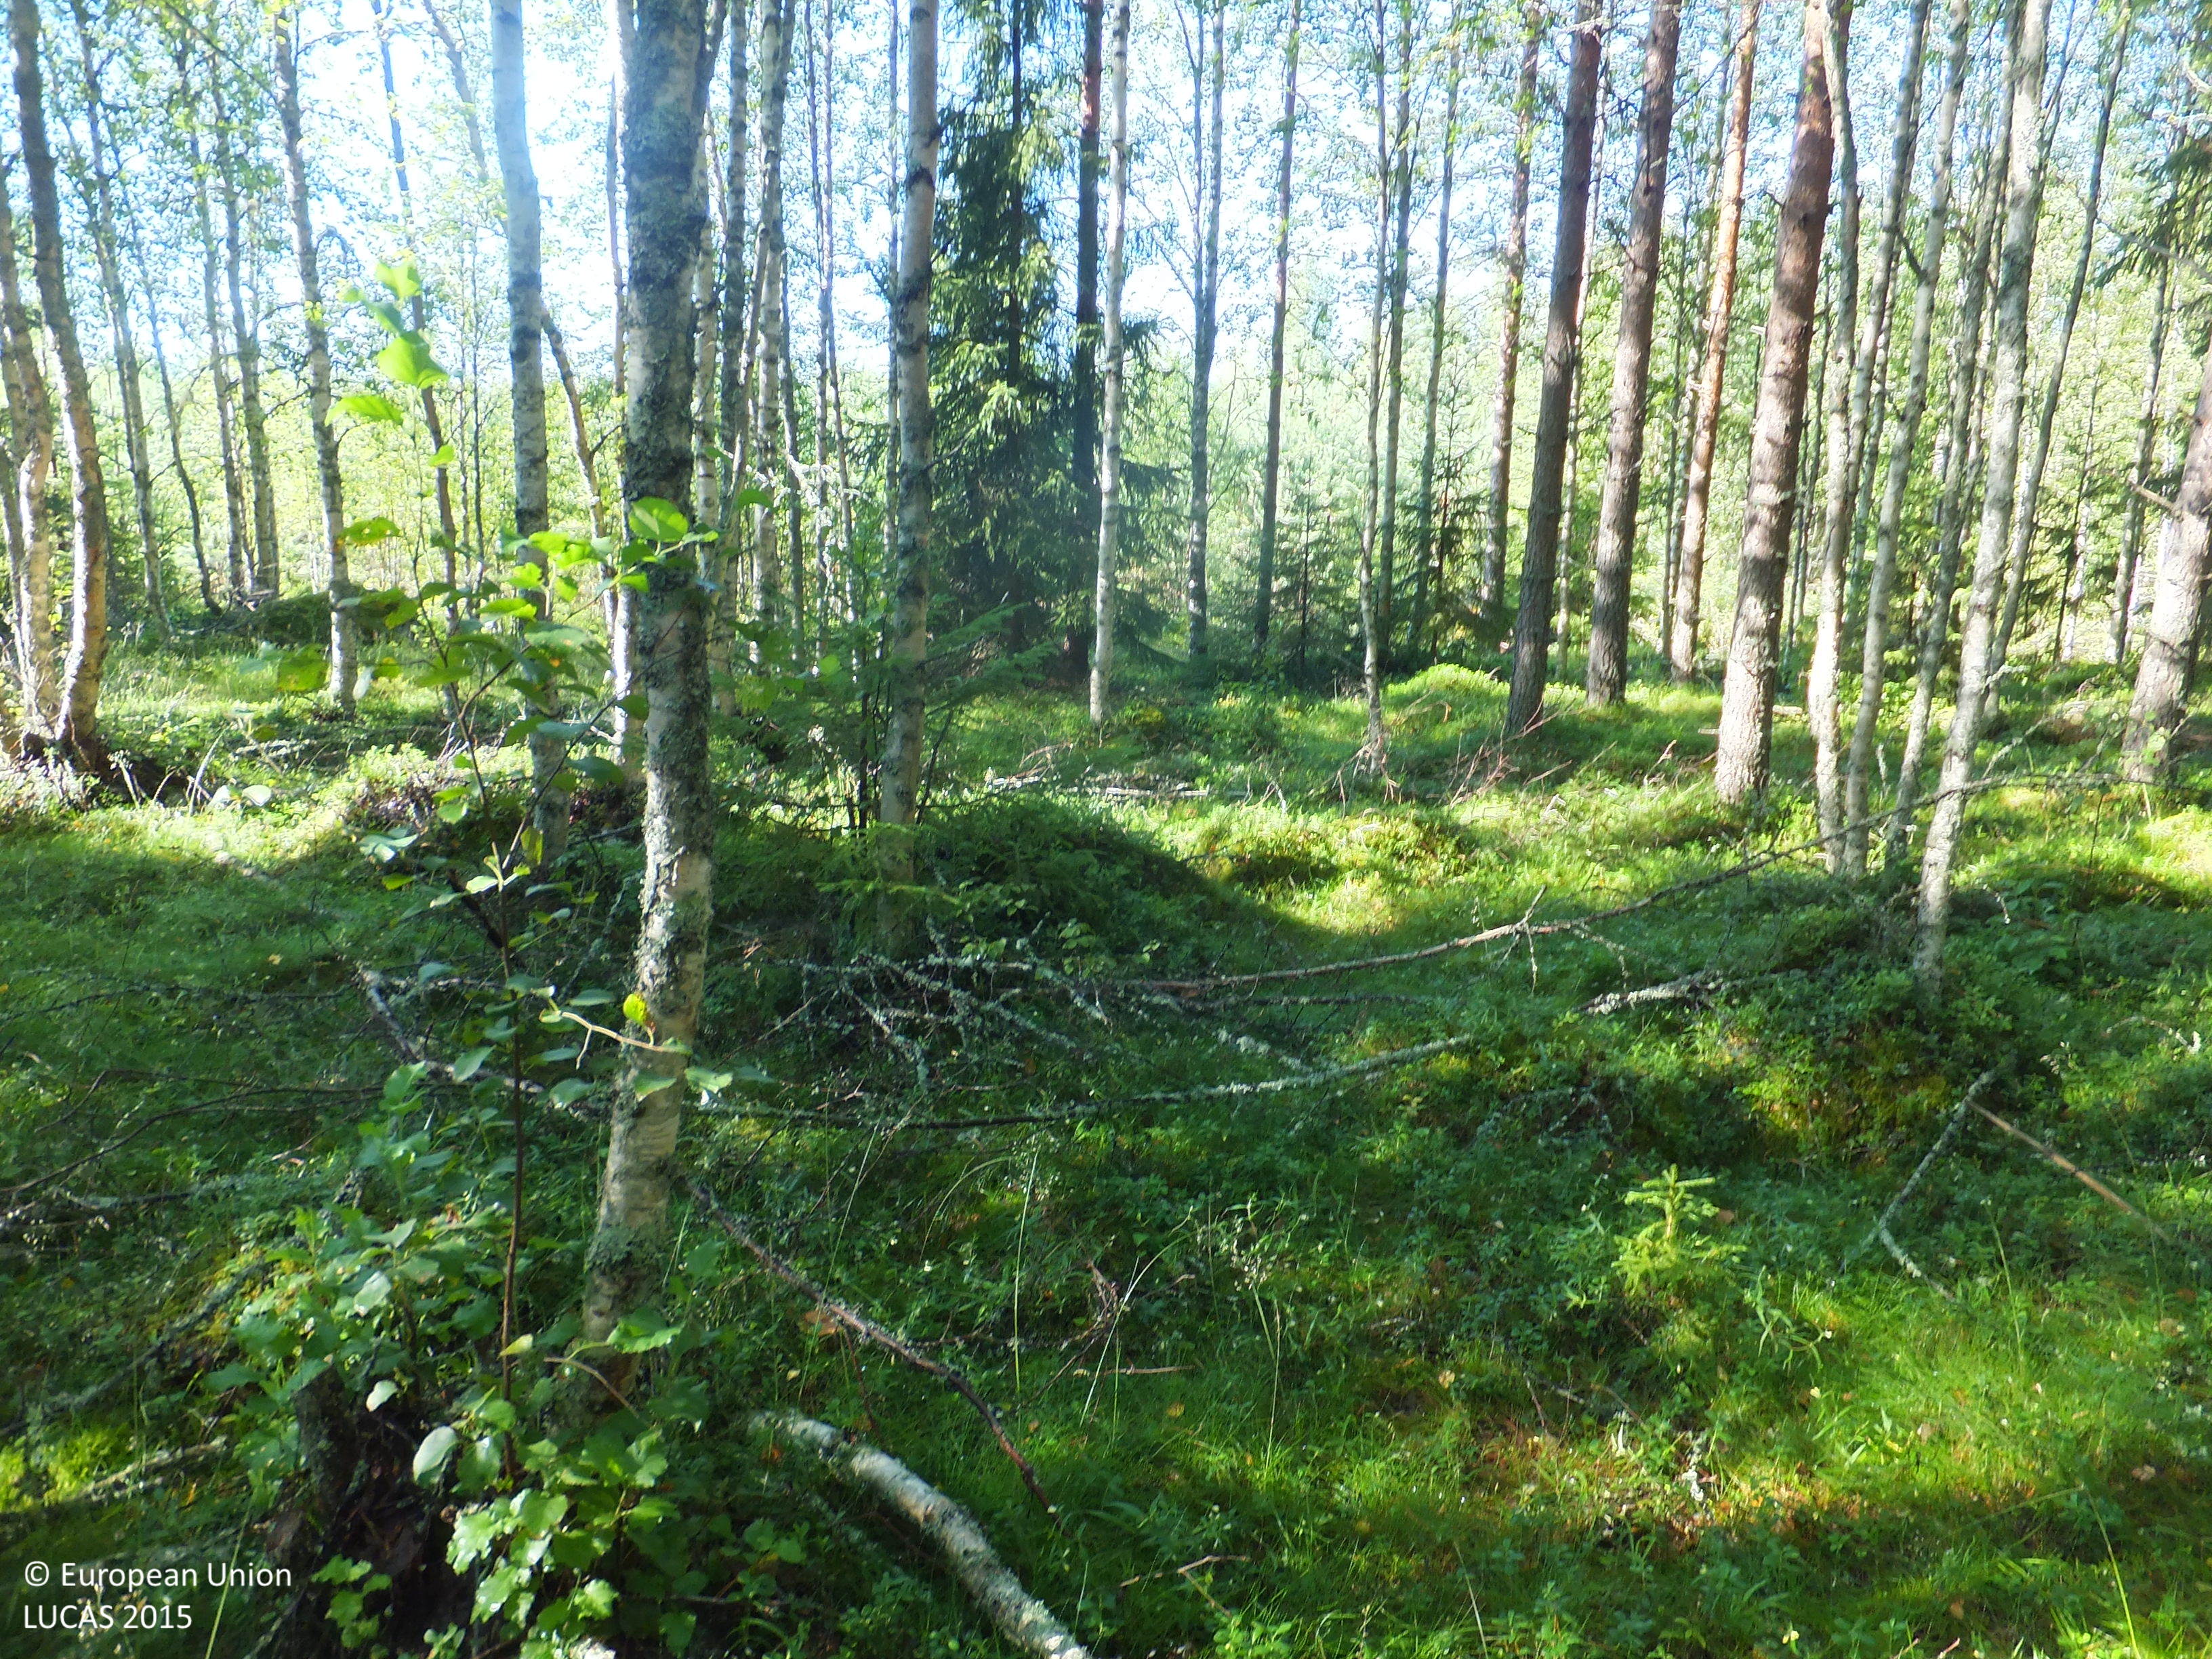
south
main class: Woodland
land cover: Broadleaved woodland
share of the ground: 50 - 75 %
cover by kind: broadleaved forest trees 60 %, shrubs 15 %, herbaceous plants 10 %, lichens and mosses 10 %, coniferous forest trees 5 %
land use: Forestry
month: August
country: FI
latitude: 63.1503
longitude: 22.0512
